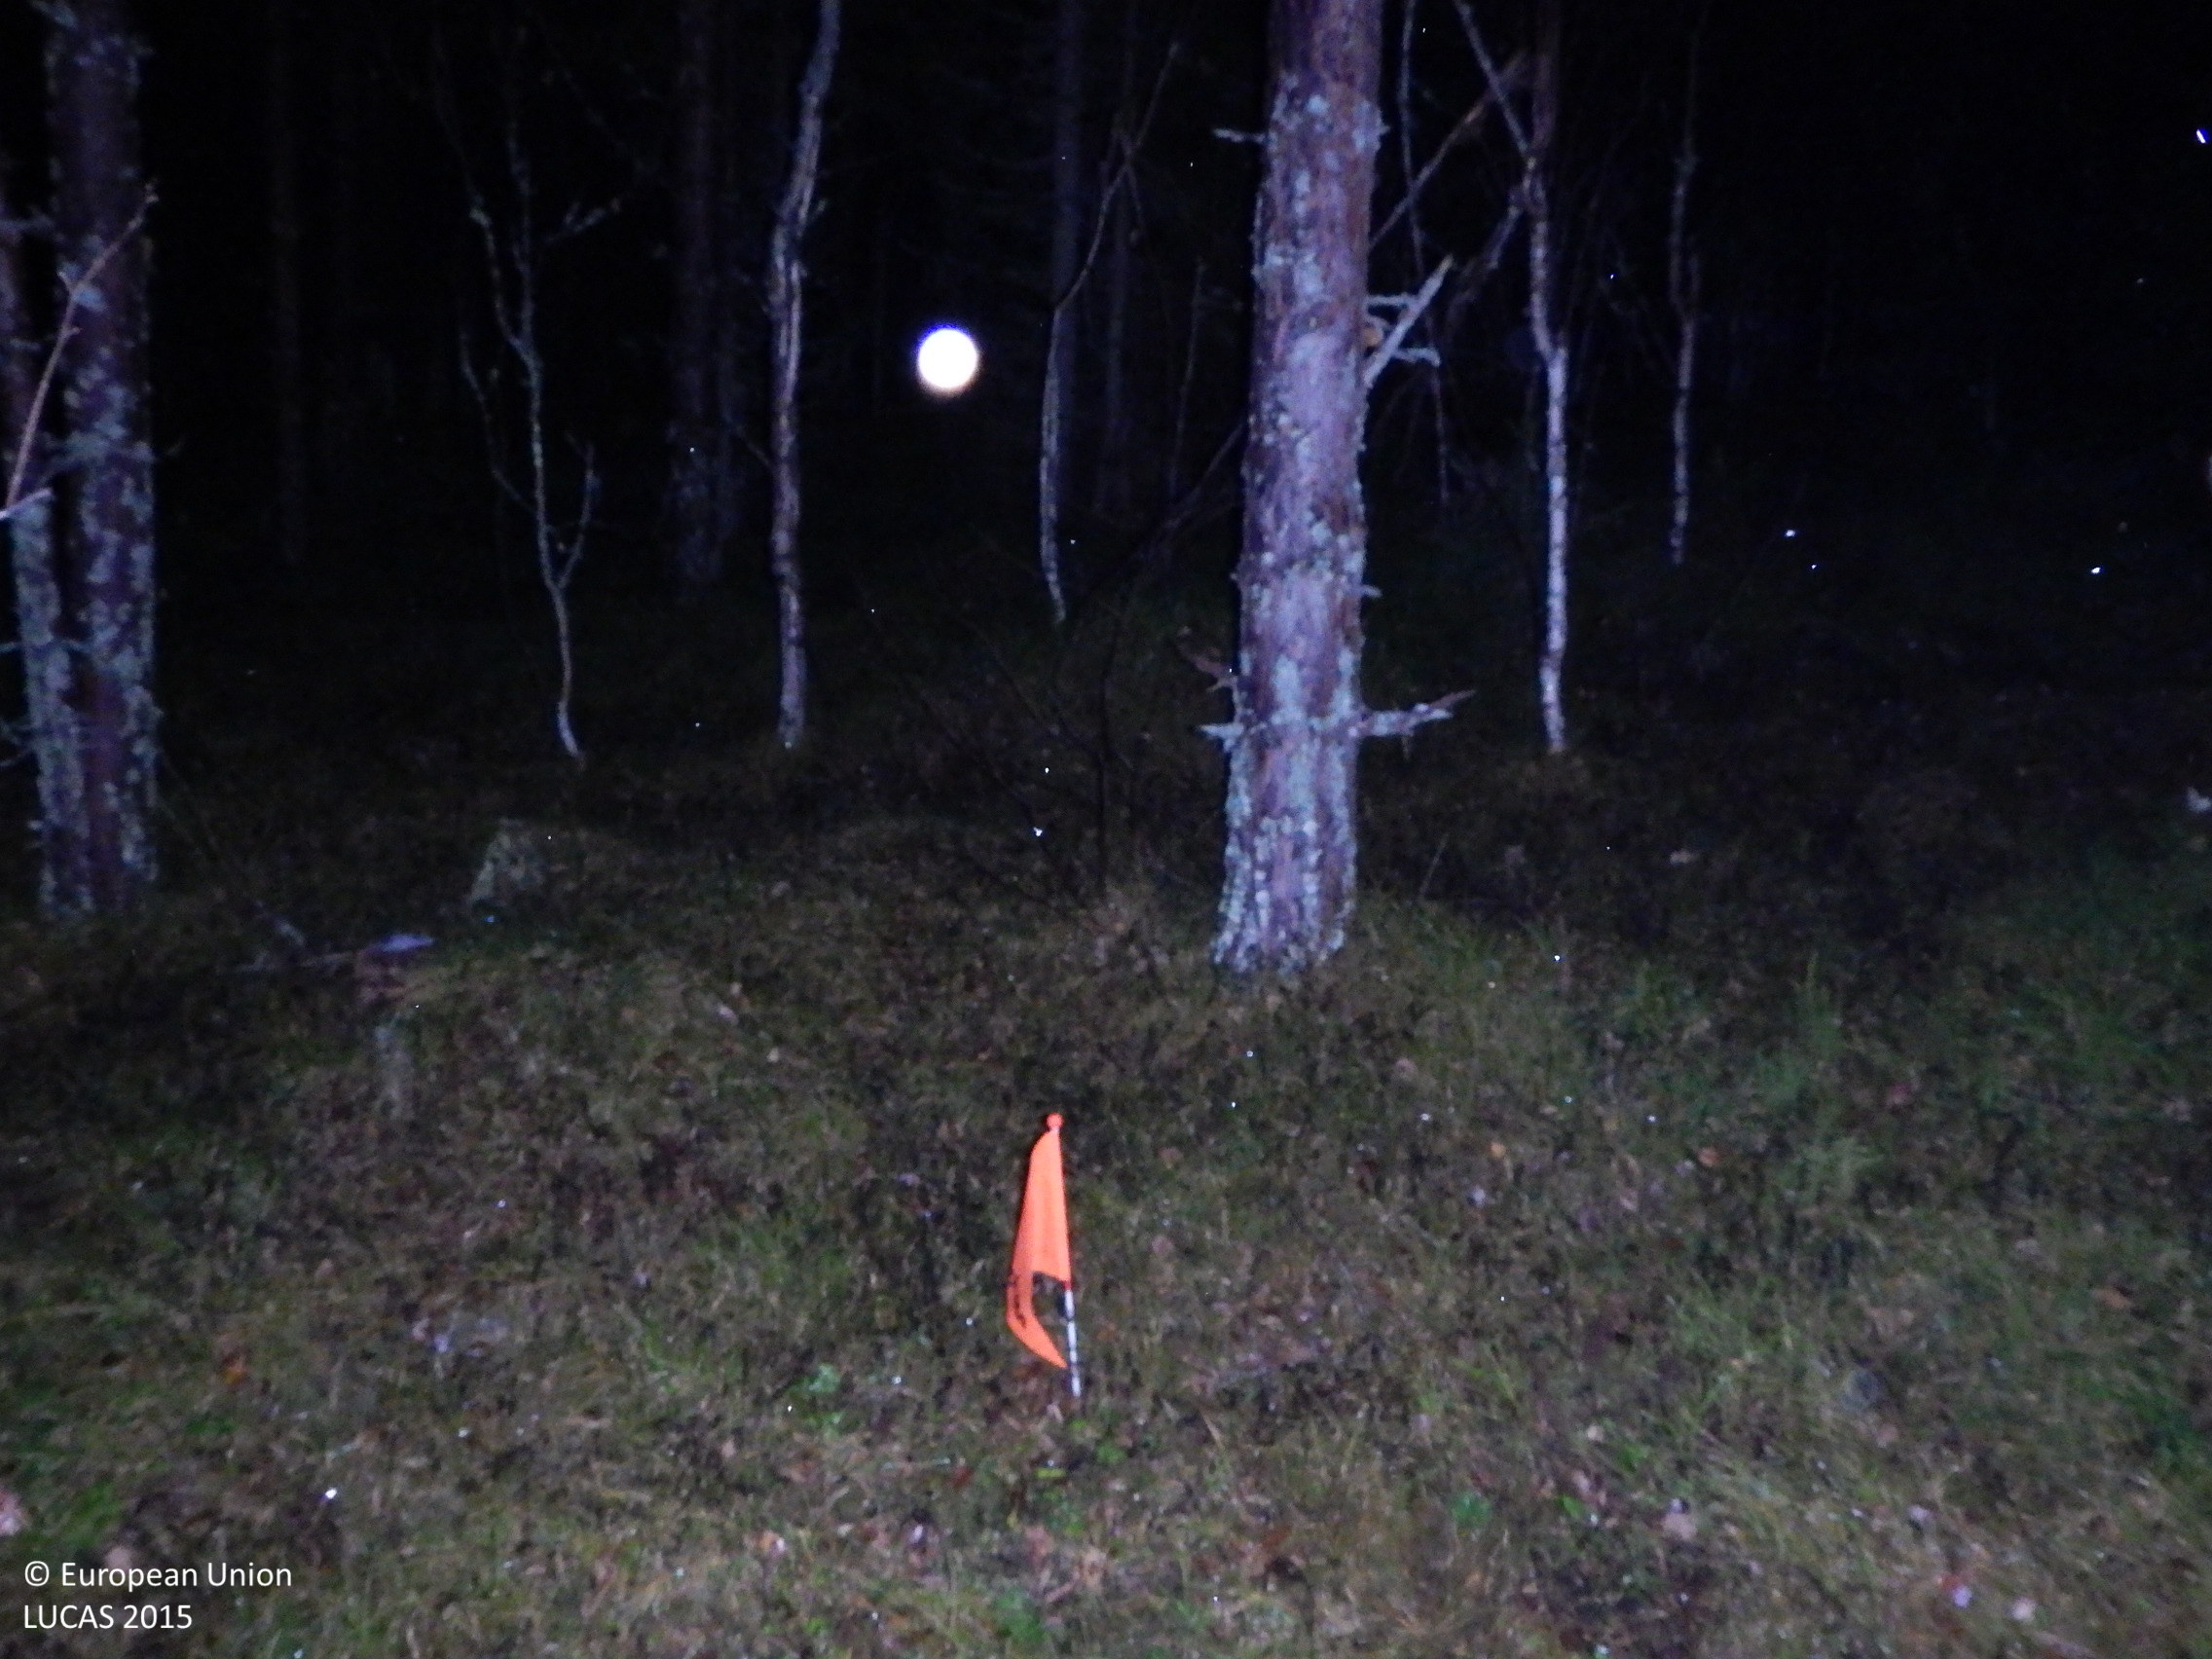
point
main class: Woodland
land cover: Pine dominated coniferous woodland
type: boreal forest
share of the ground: > 75 %
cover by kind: coniferous forest trees 65 %, broadleaved forest trees 10 %, shrubs 10 %, herbaceous plants 10 %, lichens and mosses 5 %
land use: Forestry
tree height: > 5 m
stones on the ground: < 10 %
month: November
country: SE
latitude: 61.4797
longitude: 16.8373
